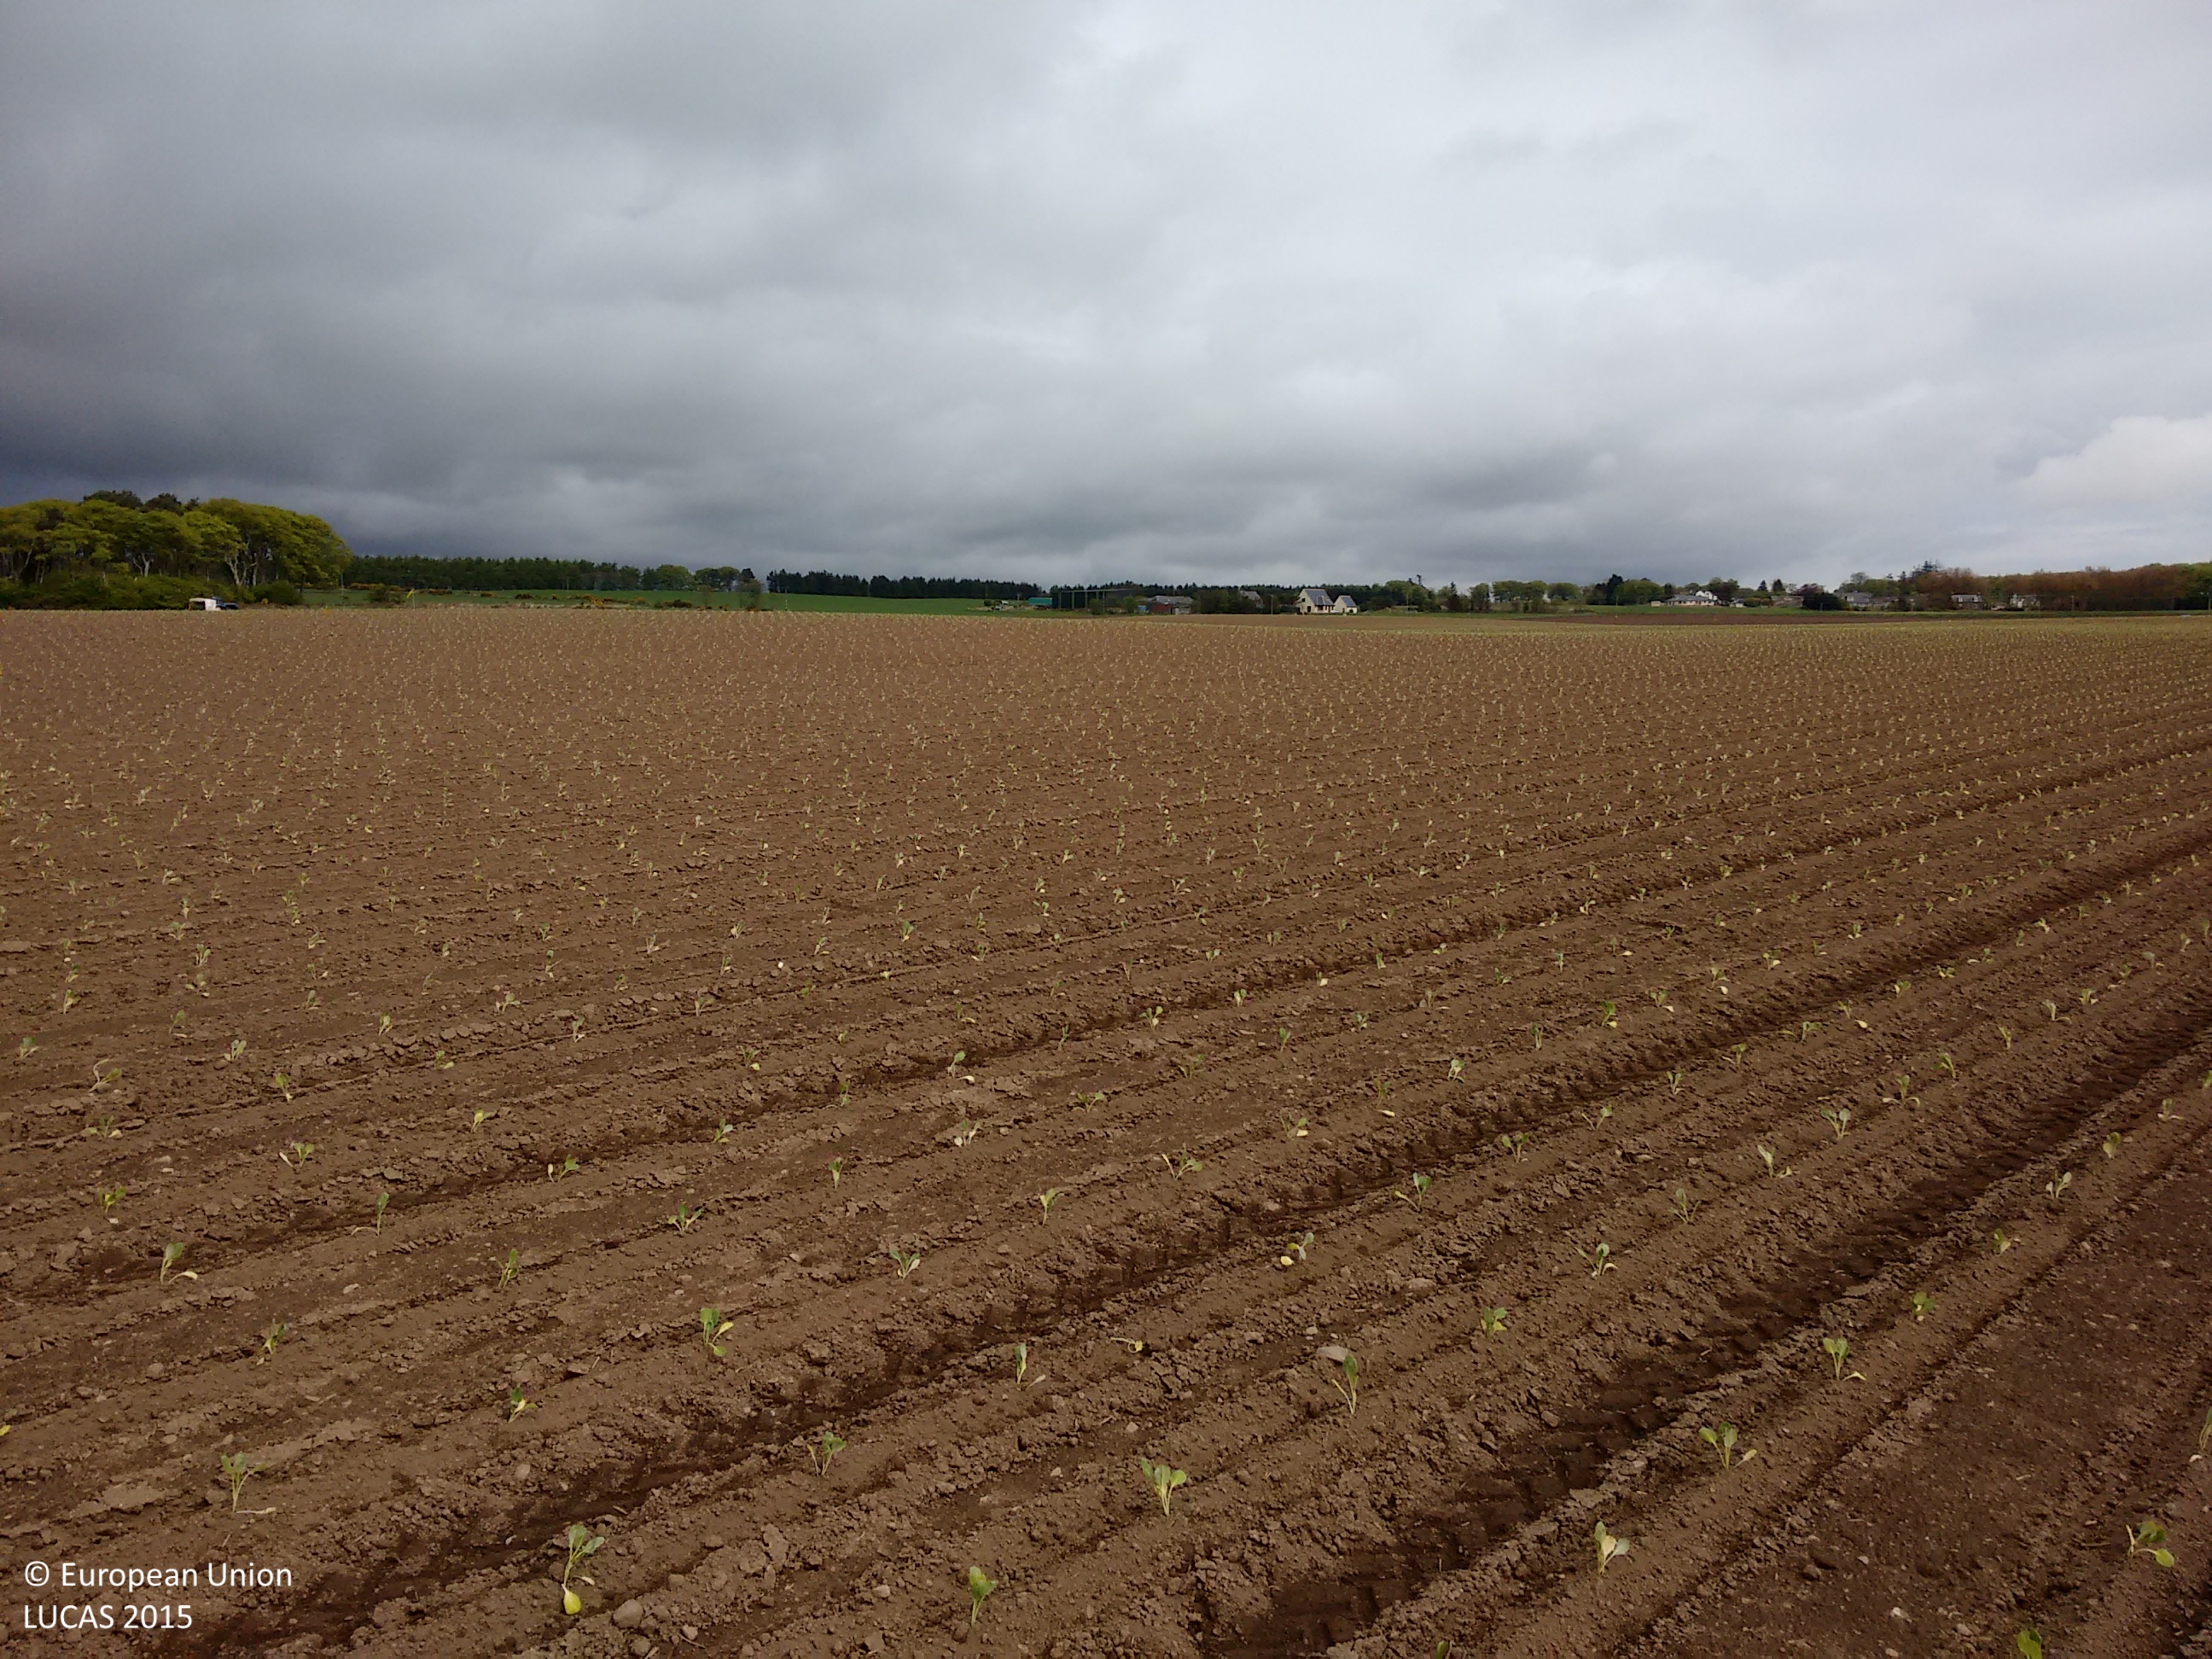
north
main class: Cropland
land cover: Other fresh vegetables
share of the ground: < 10 %
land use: Agriculture (excluding fallow land and kitchen gardens)
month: May
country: GB
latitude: 56.5862
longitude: -2.5793
